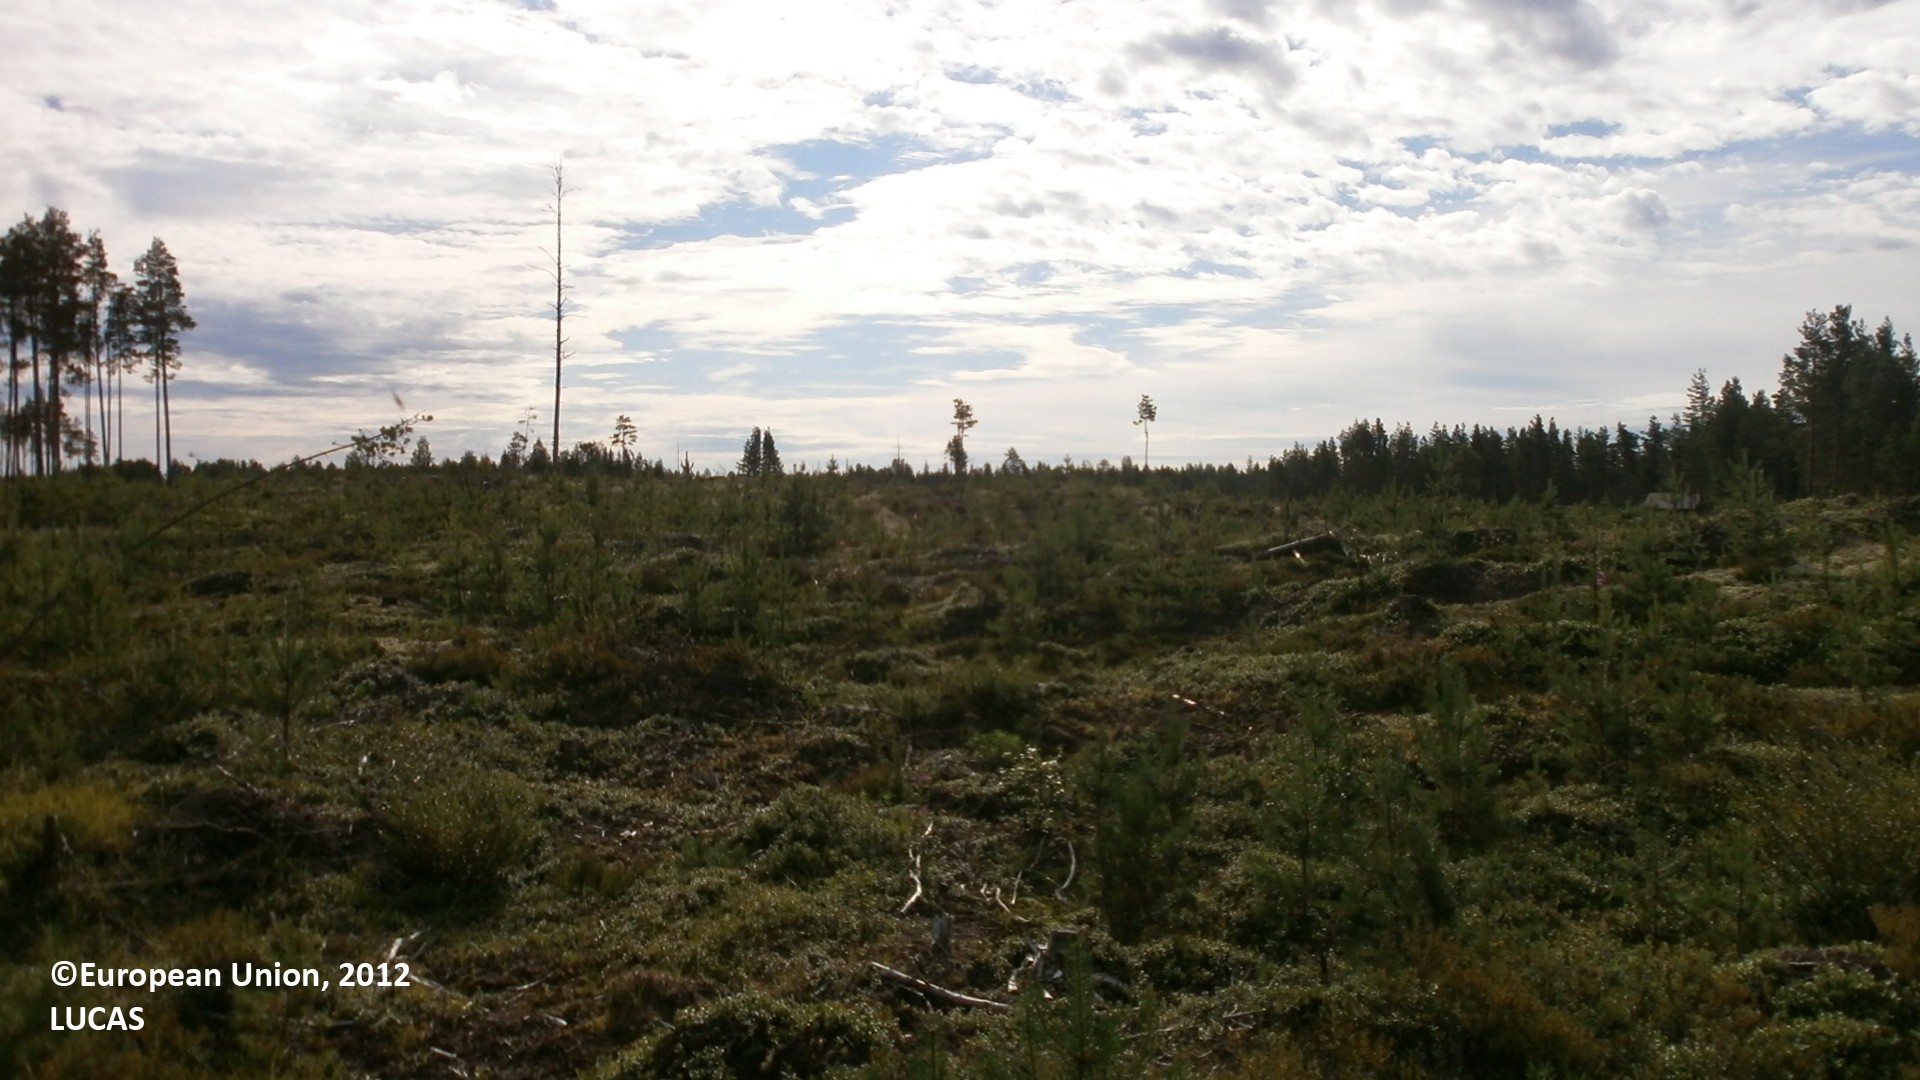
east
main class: Woodland
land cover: Pine dominated coniferous woodland
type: boreal forest
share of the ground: 10 - 25 %
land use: Forestry
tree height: < 5 m
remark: Clear cut
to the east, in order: Pine dominated coniferous woodland; Shrubland with sparse tree cover; Pine dominated coniferous woodland; Lichens and moss; Pine dominated coniferous woodland; Shrubland with sparse tree cover; Pine dominated coniferous woodland
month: July
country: FI
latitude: 64.0837
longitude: 24.0304
